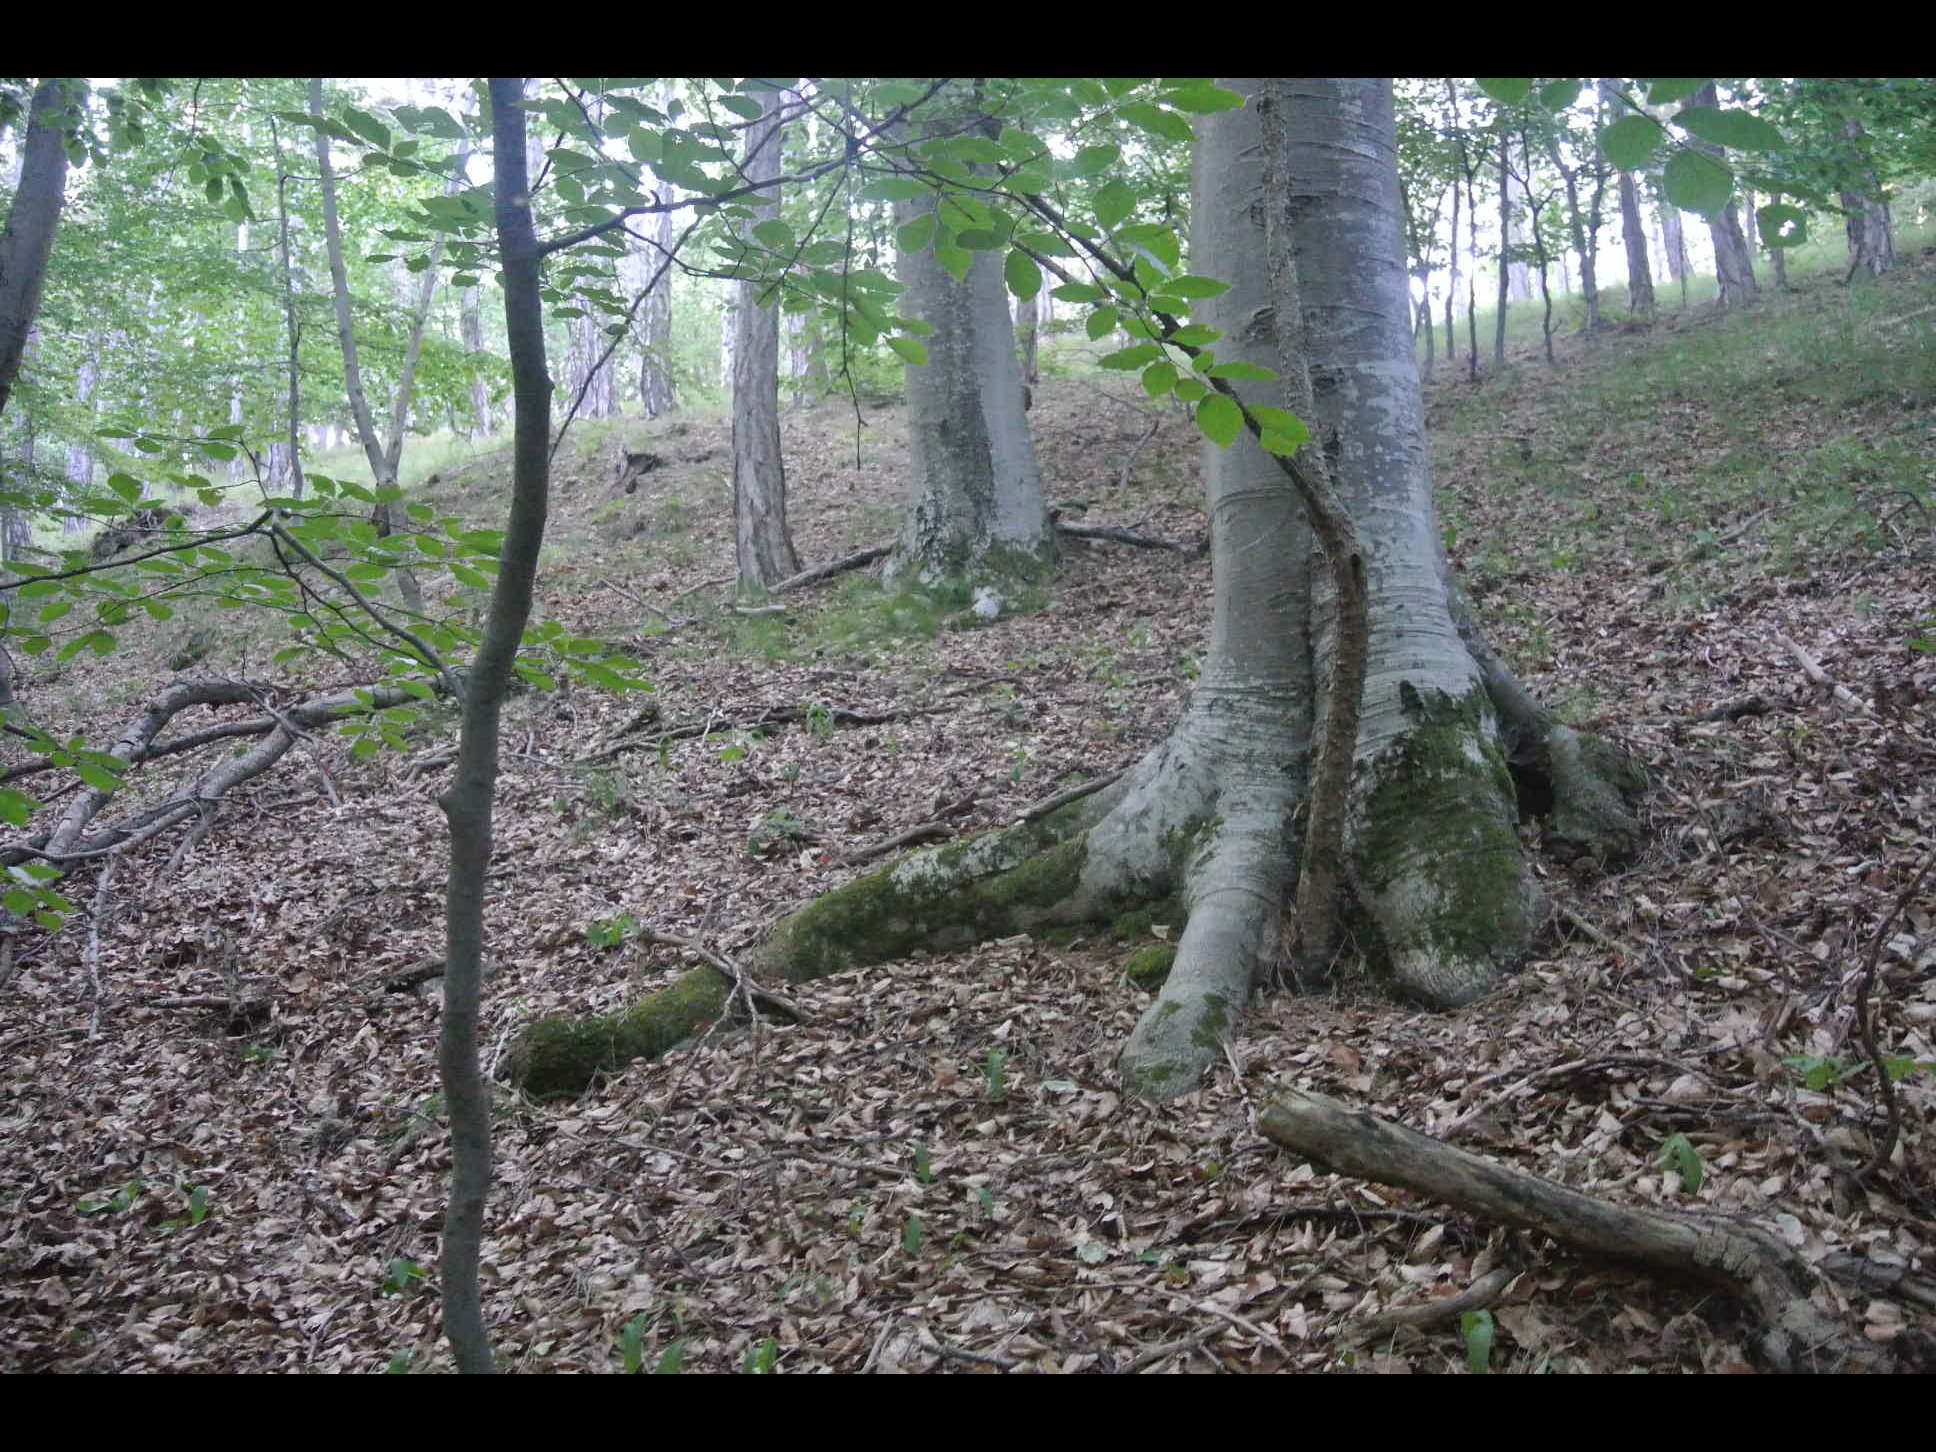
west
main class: Woodland
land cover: Pine dominated mixed woodland
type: beech forest
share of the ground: > 75 %
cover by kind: broadleaved forest trees 75 %, coniferous forest trees 25 %
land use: Forestry
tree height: > 5 m
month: July
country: AT
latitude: 47.9959
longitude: 16.1820
